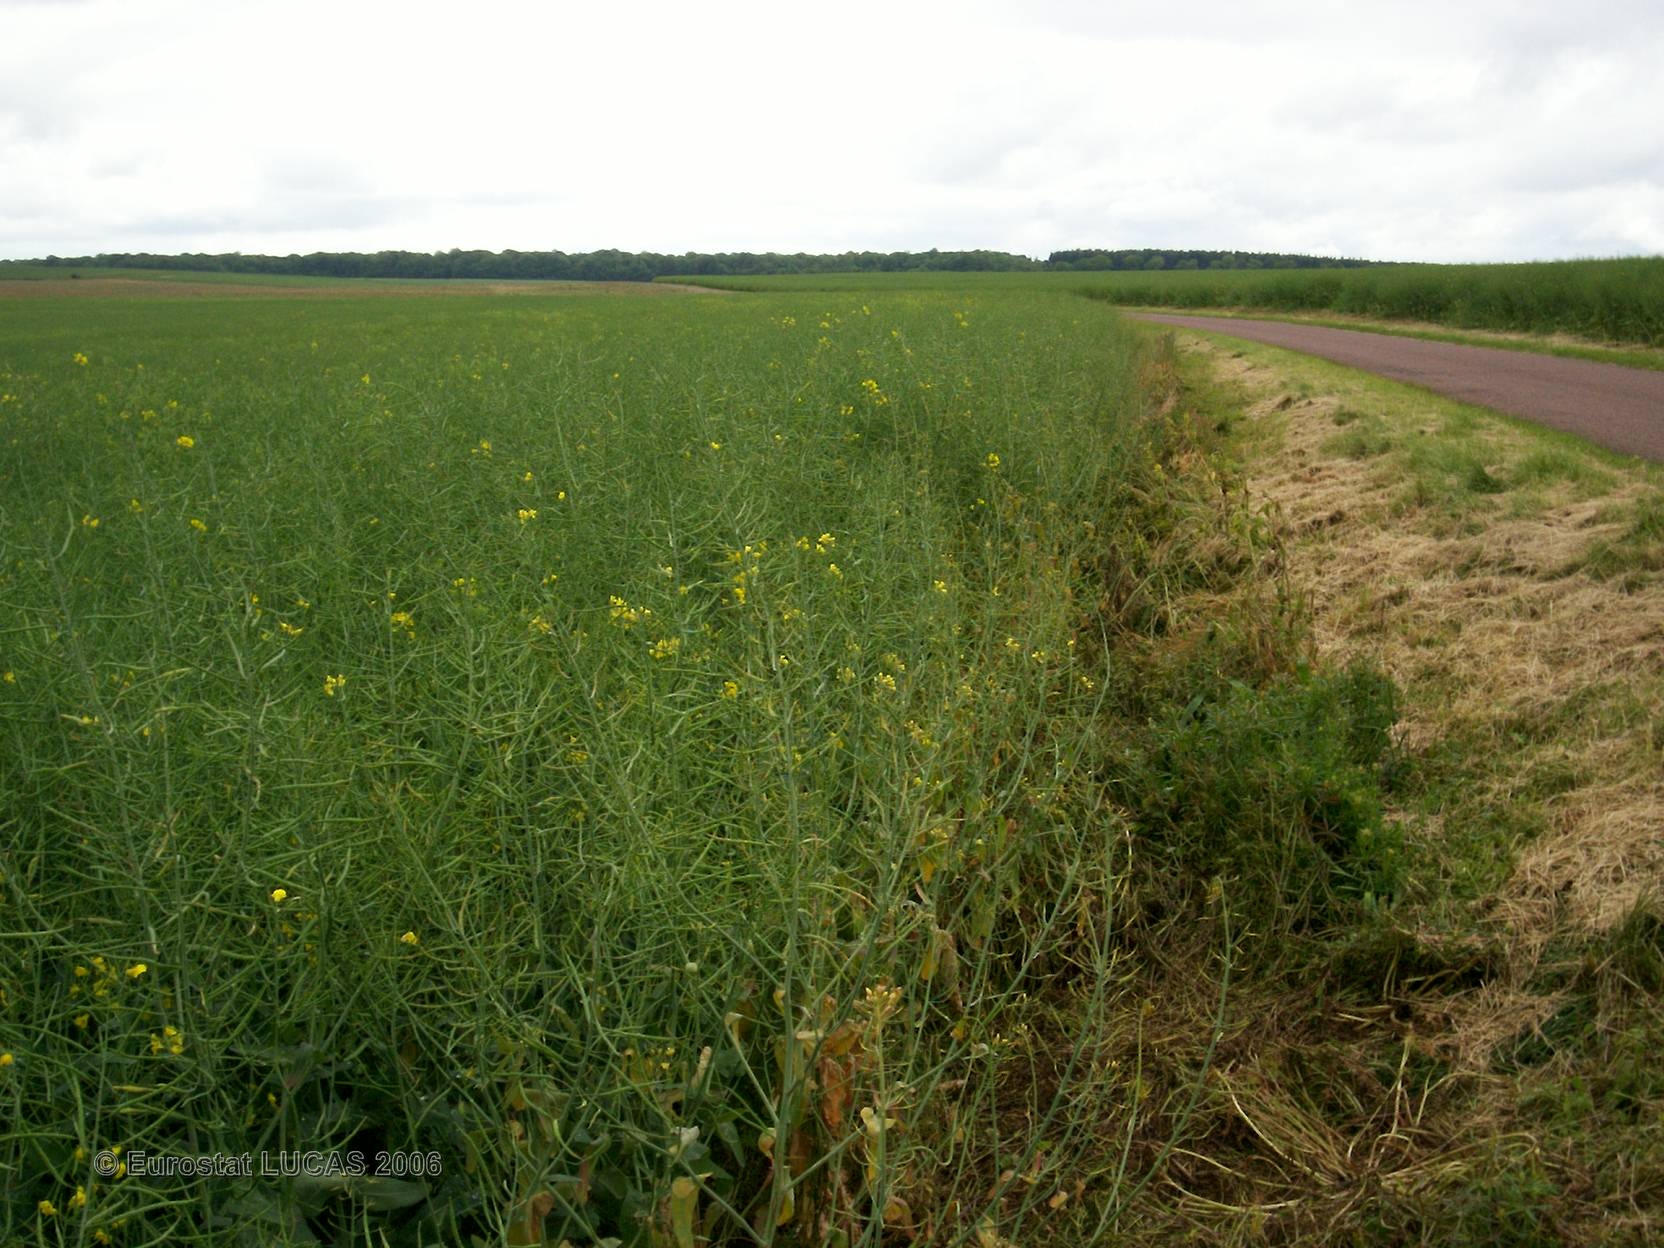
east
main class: Cropland
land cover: Rape and turnip rape
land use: Agriculture (excluding fallow land and kitchen gardens)
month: May
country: FR
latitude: 48.1969
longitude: 4.5491
